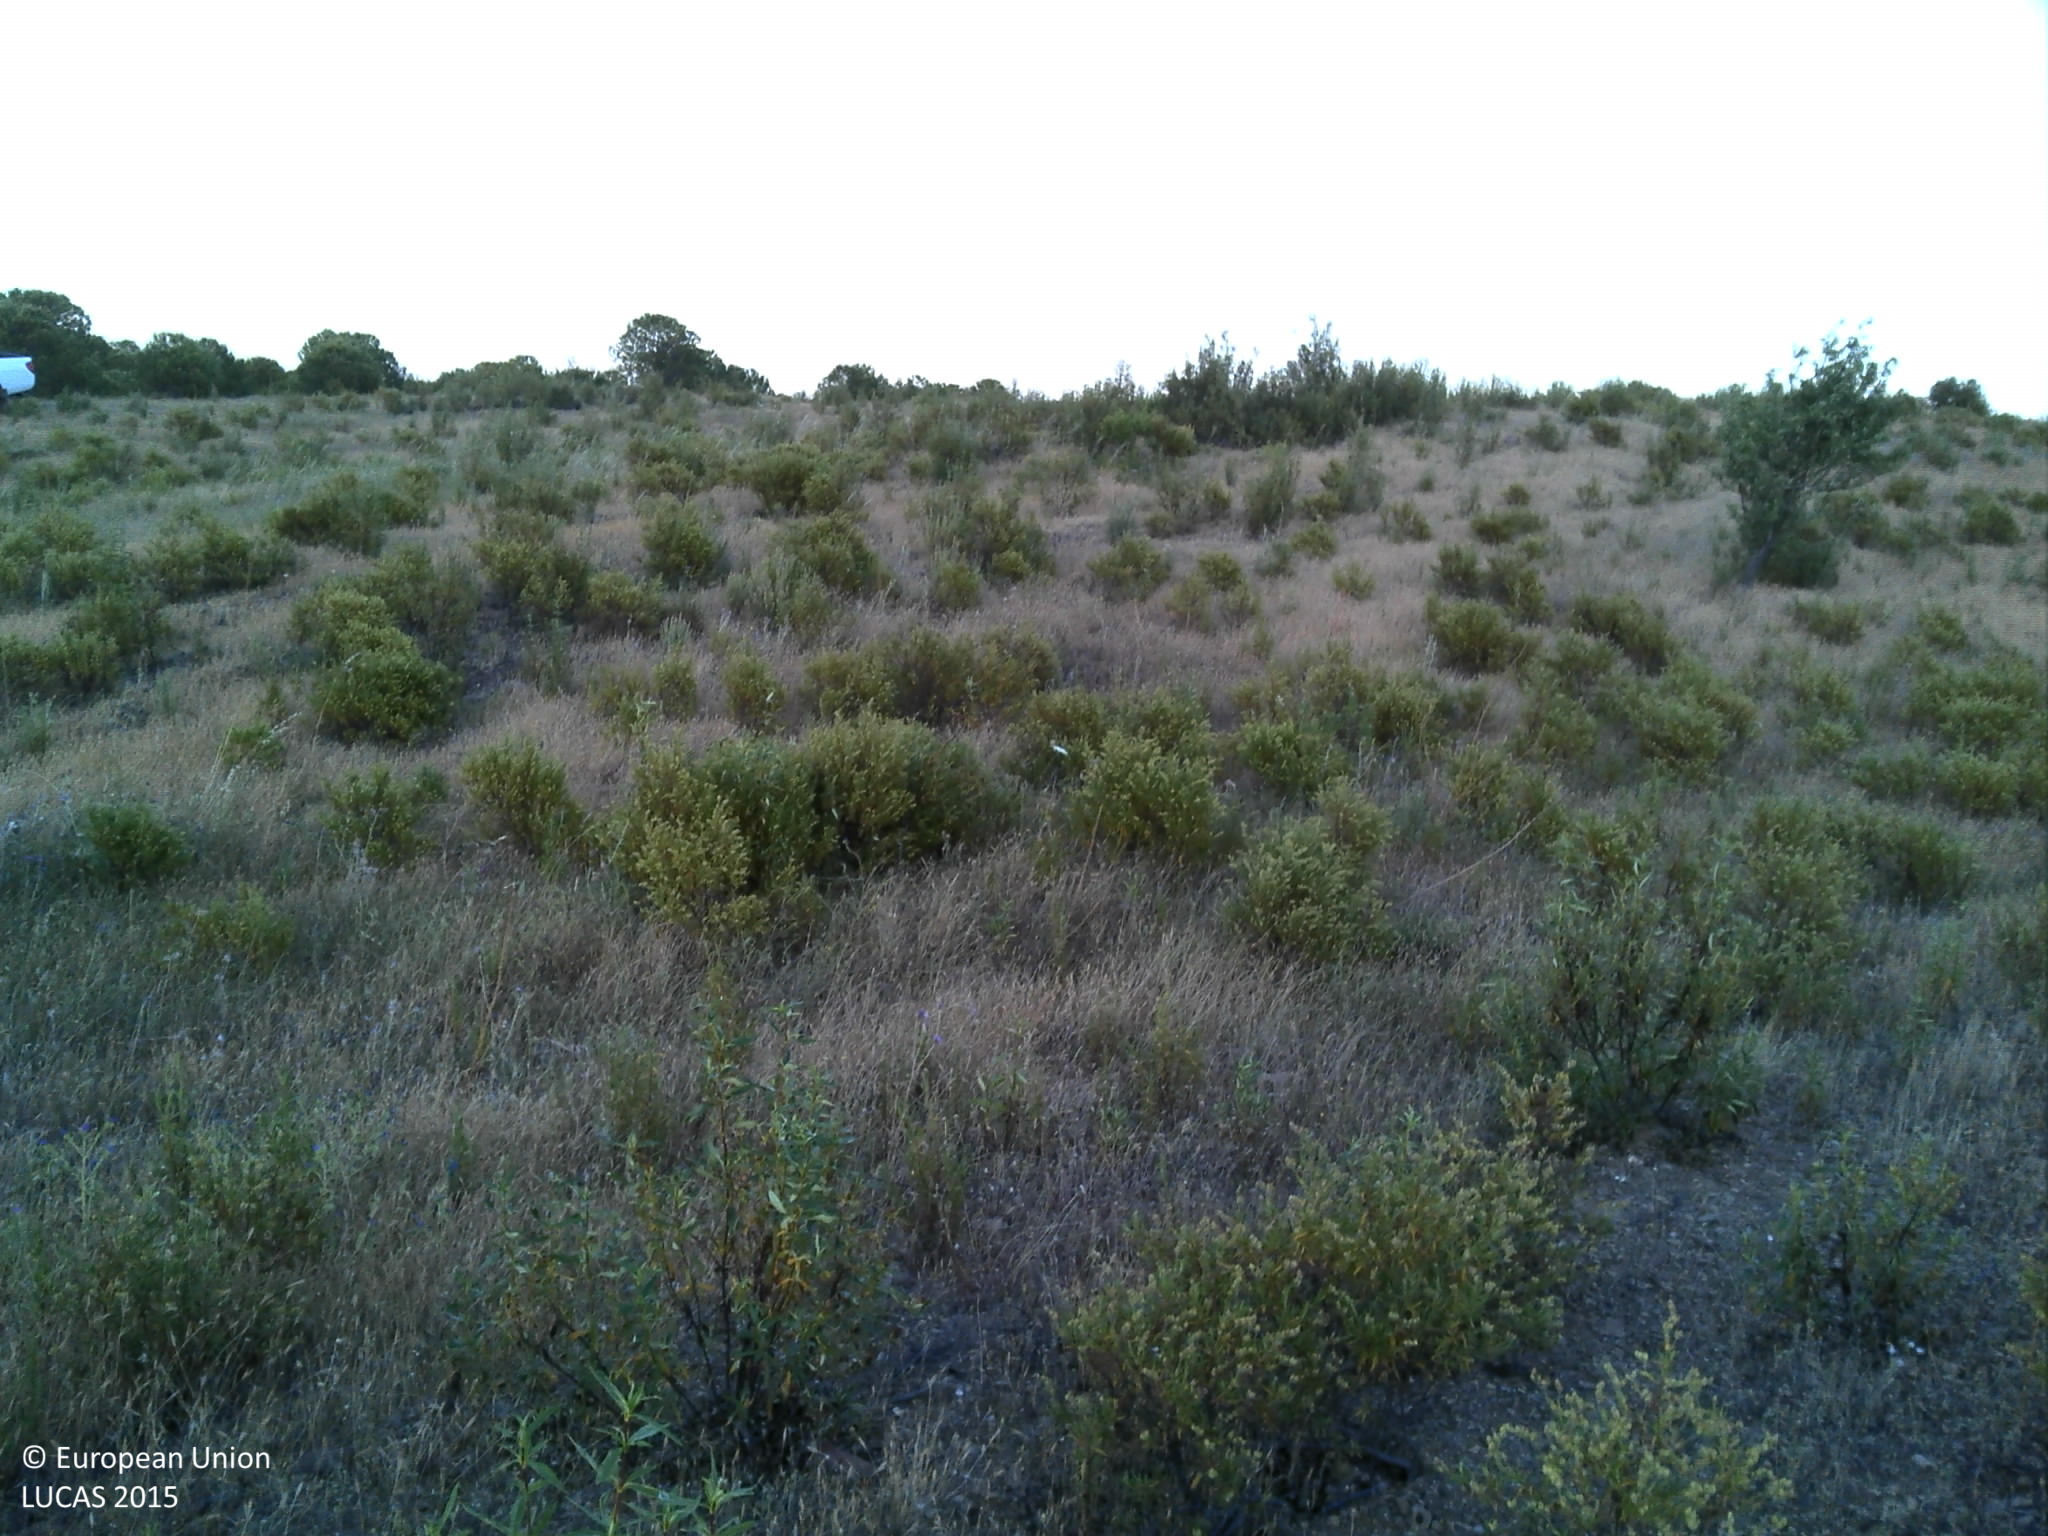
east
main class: Shrubland
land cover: Shrubland without tree cover
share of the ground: 10 - 25 %
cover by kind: herbaceous plants 65 %, shrubs 25 %, unconsolidated bare surface 10 %
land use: Abandoned areas
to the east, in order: Shrubland without tree cover; Pine dominated coniferous woodland; Rivers and streams; Pine dominated coniferous woodland; Tracks; Pine dominated coniferous woodland; Grass margins; Tracks; Shrubland without tree cover
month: May
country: PT
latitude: 37.4356
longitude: -7.5379
